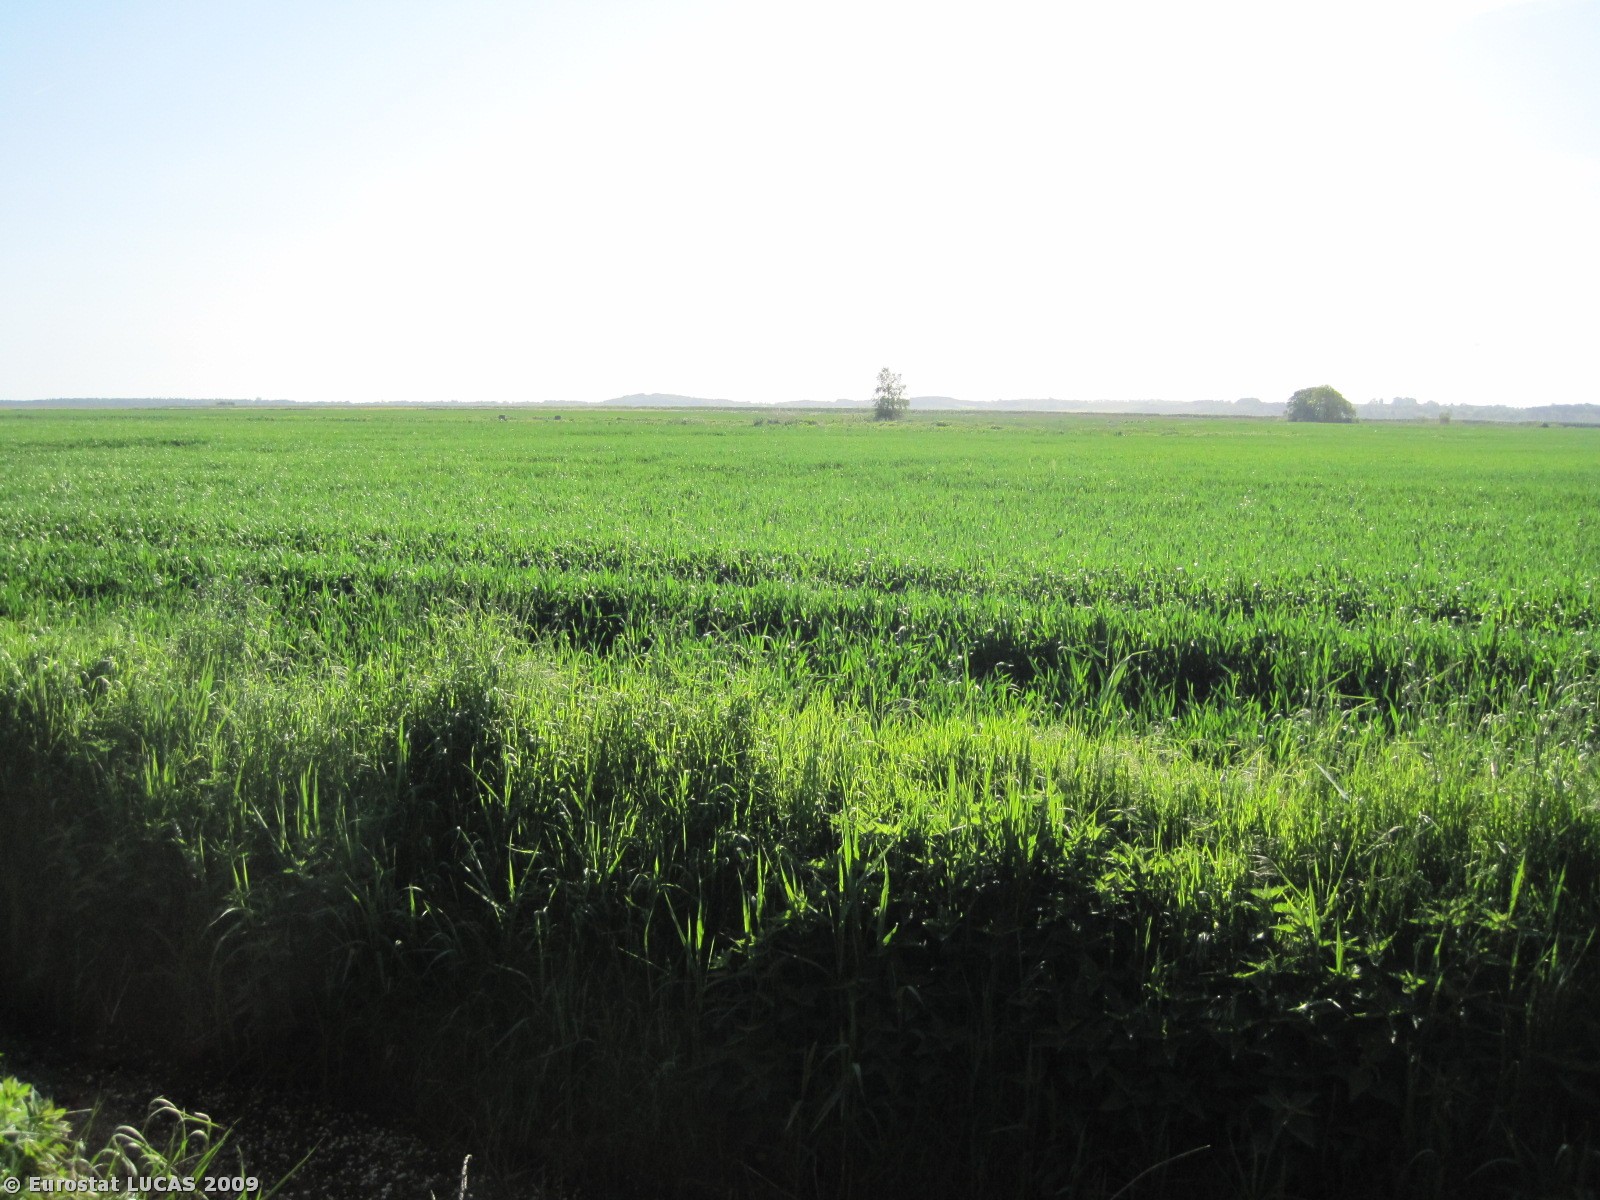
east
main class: Woodland
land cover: Mixed woodland
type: plantations and self-sown exotic forest
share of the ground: > 75 %
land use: Unused
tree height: > 5 m
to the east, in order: Mixed woodland; Grassland without tree/shrub cover; Ditches and canals; Grass margins; Grassland without tree/shrub cover; Ditches and canals; Single bushes/trees; Grassland without tree/shrub cover; Rye; Barley
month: May
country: DK
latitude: 56.5830
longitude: 10.2439
